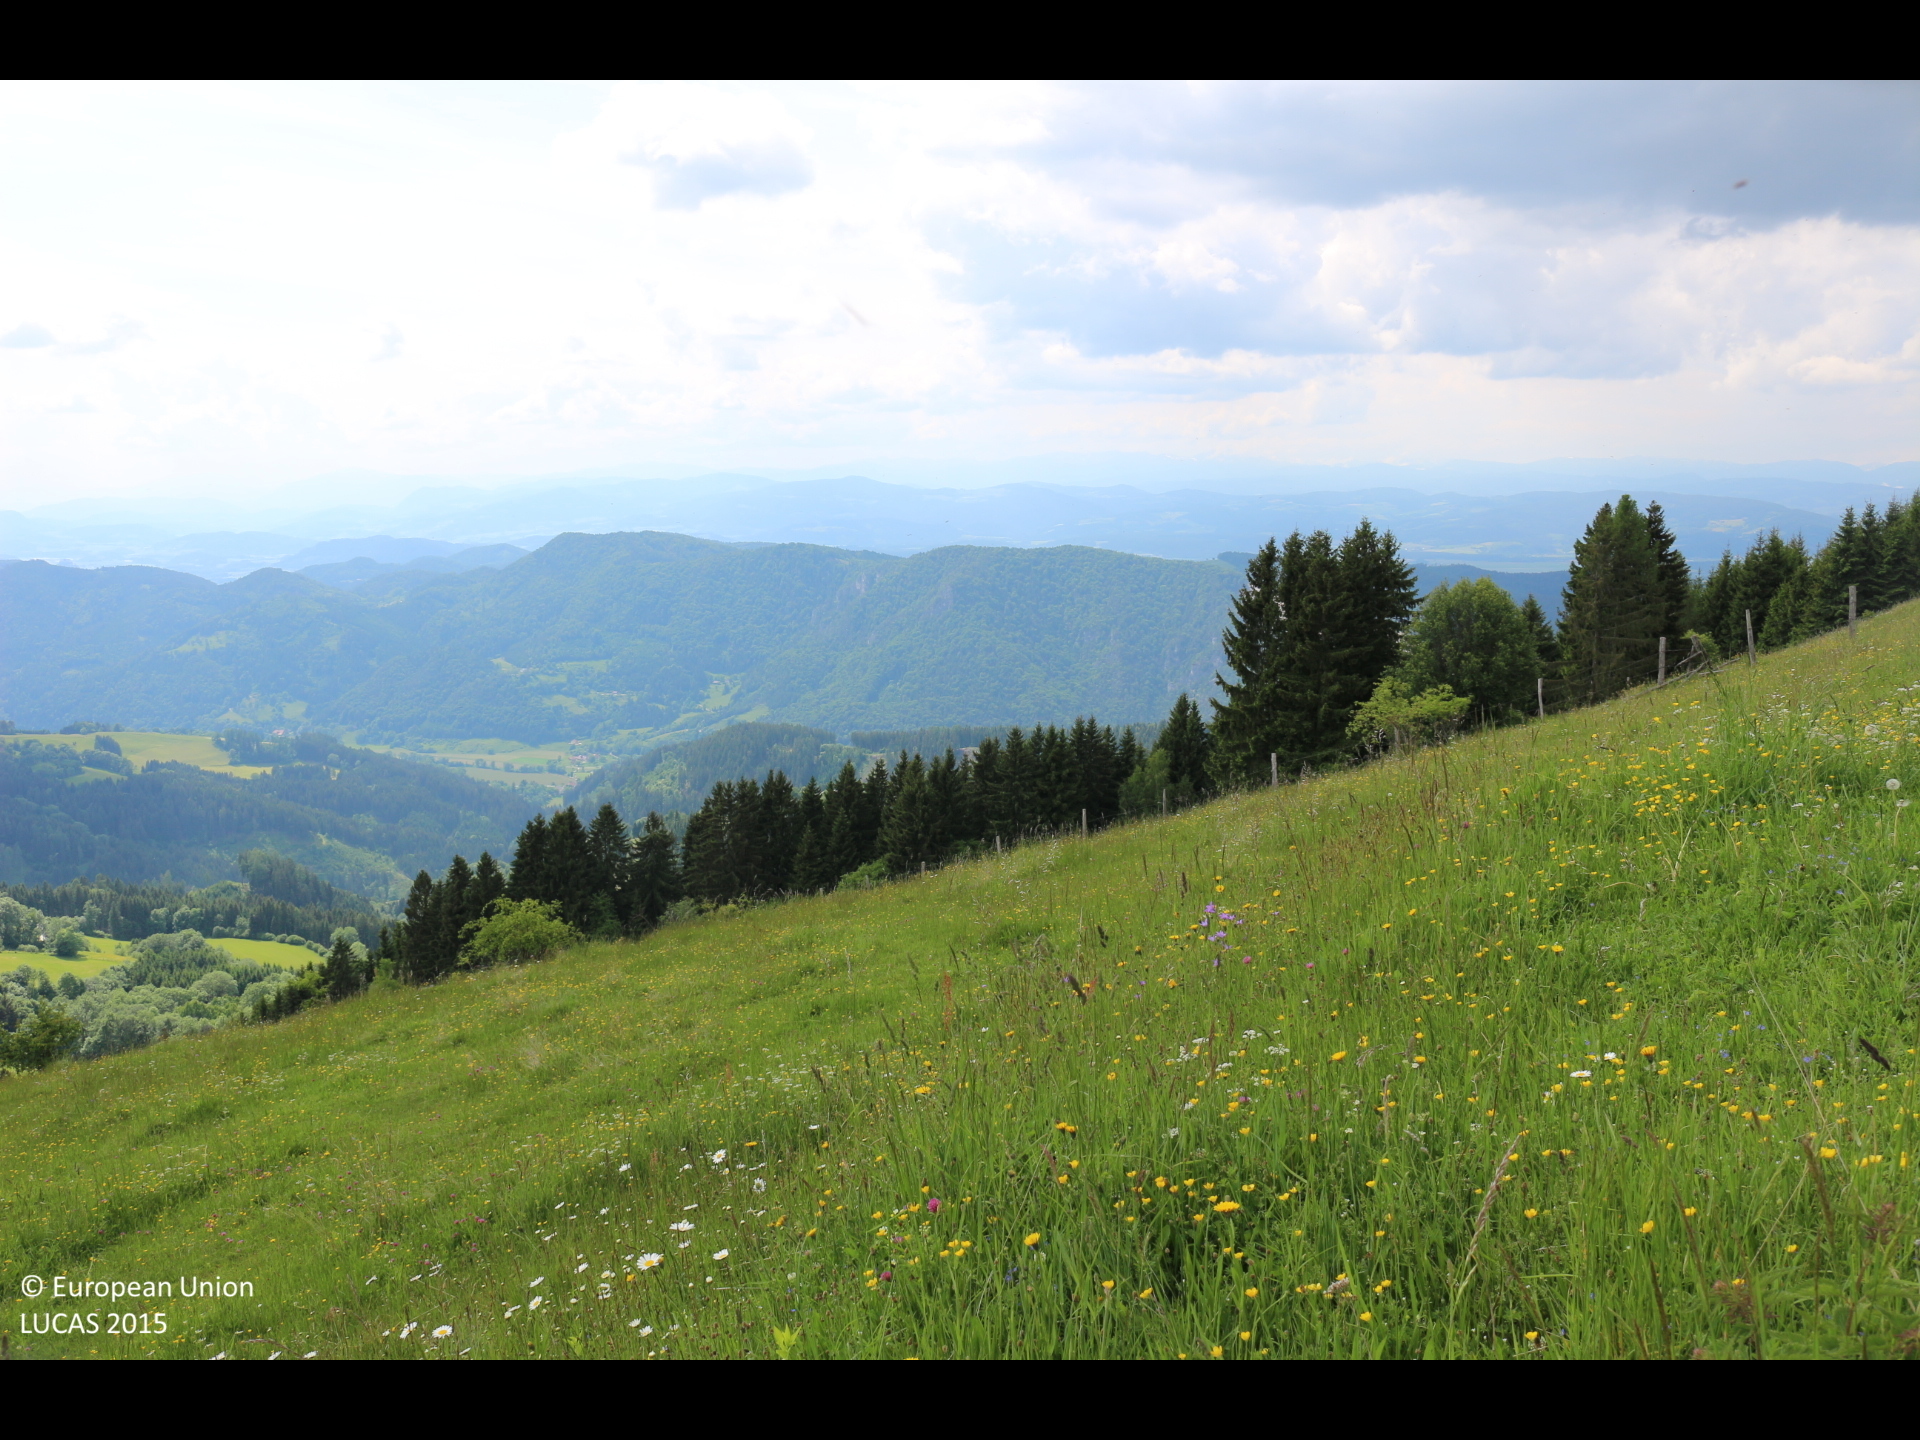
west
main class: Grassland
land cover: Grassland without tree/shrub cover
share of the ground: > 75 %
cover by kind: herbaceous plants 100 %
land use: Agriculture (excluding fallow land and kitchen gardens)
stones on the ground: < 10 %
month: June
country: AT
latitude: 46.7936
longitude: 14.5964
